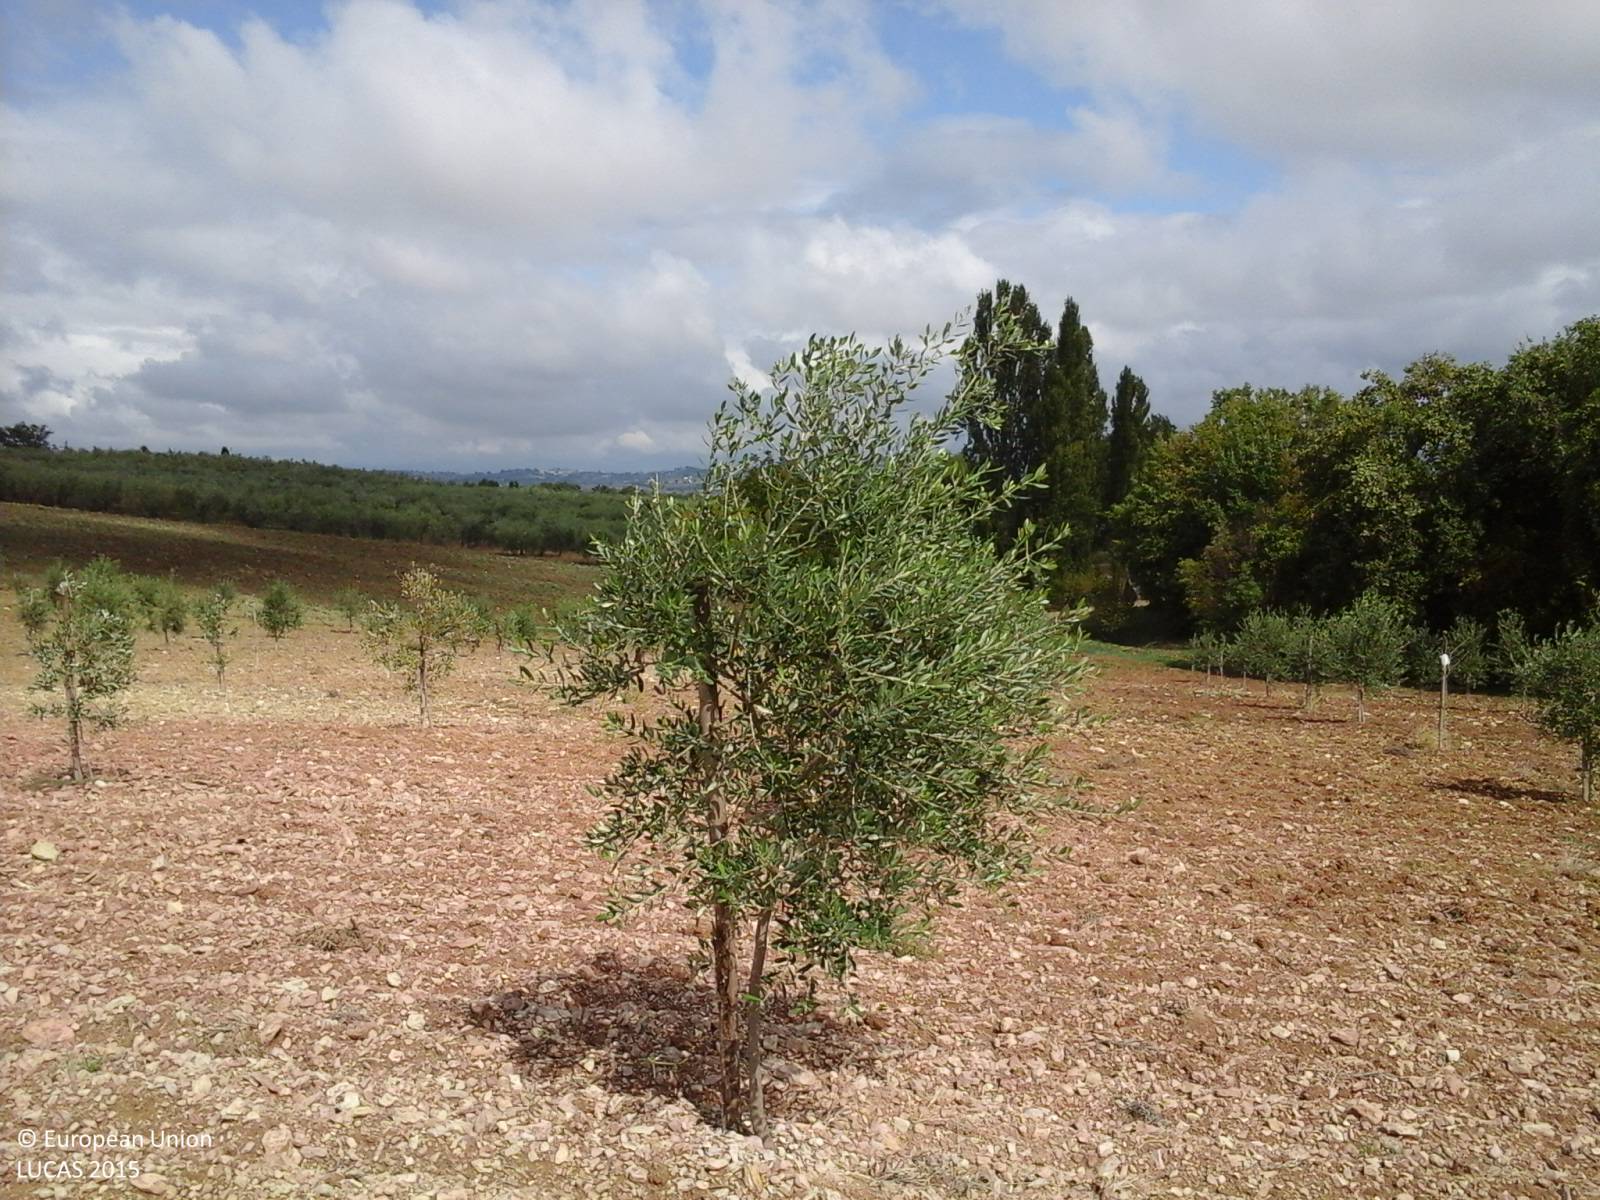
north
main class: Cropland
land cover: Olive groves
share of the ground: 10 - 25 %
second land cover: Other bare soil
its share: > 75 %
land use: Agriculture (excluding fallow land and kitchen gardens)
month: September
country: IT
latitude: 42.8375
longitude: 12.5981
